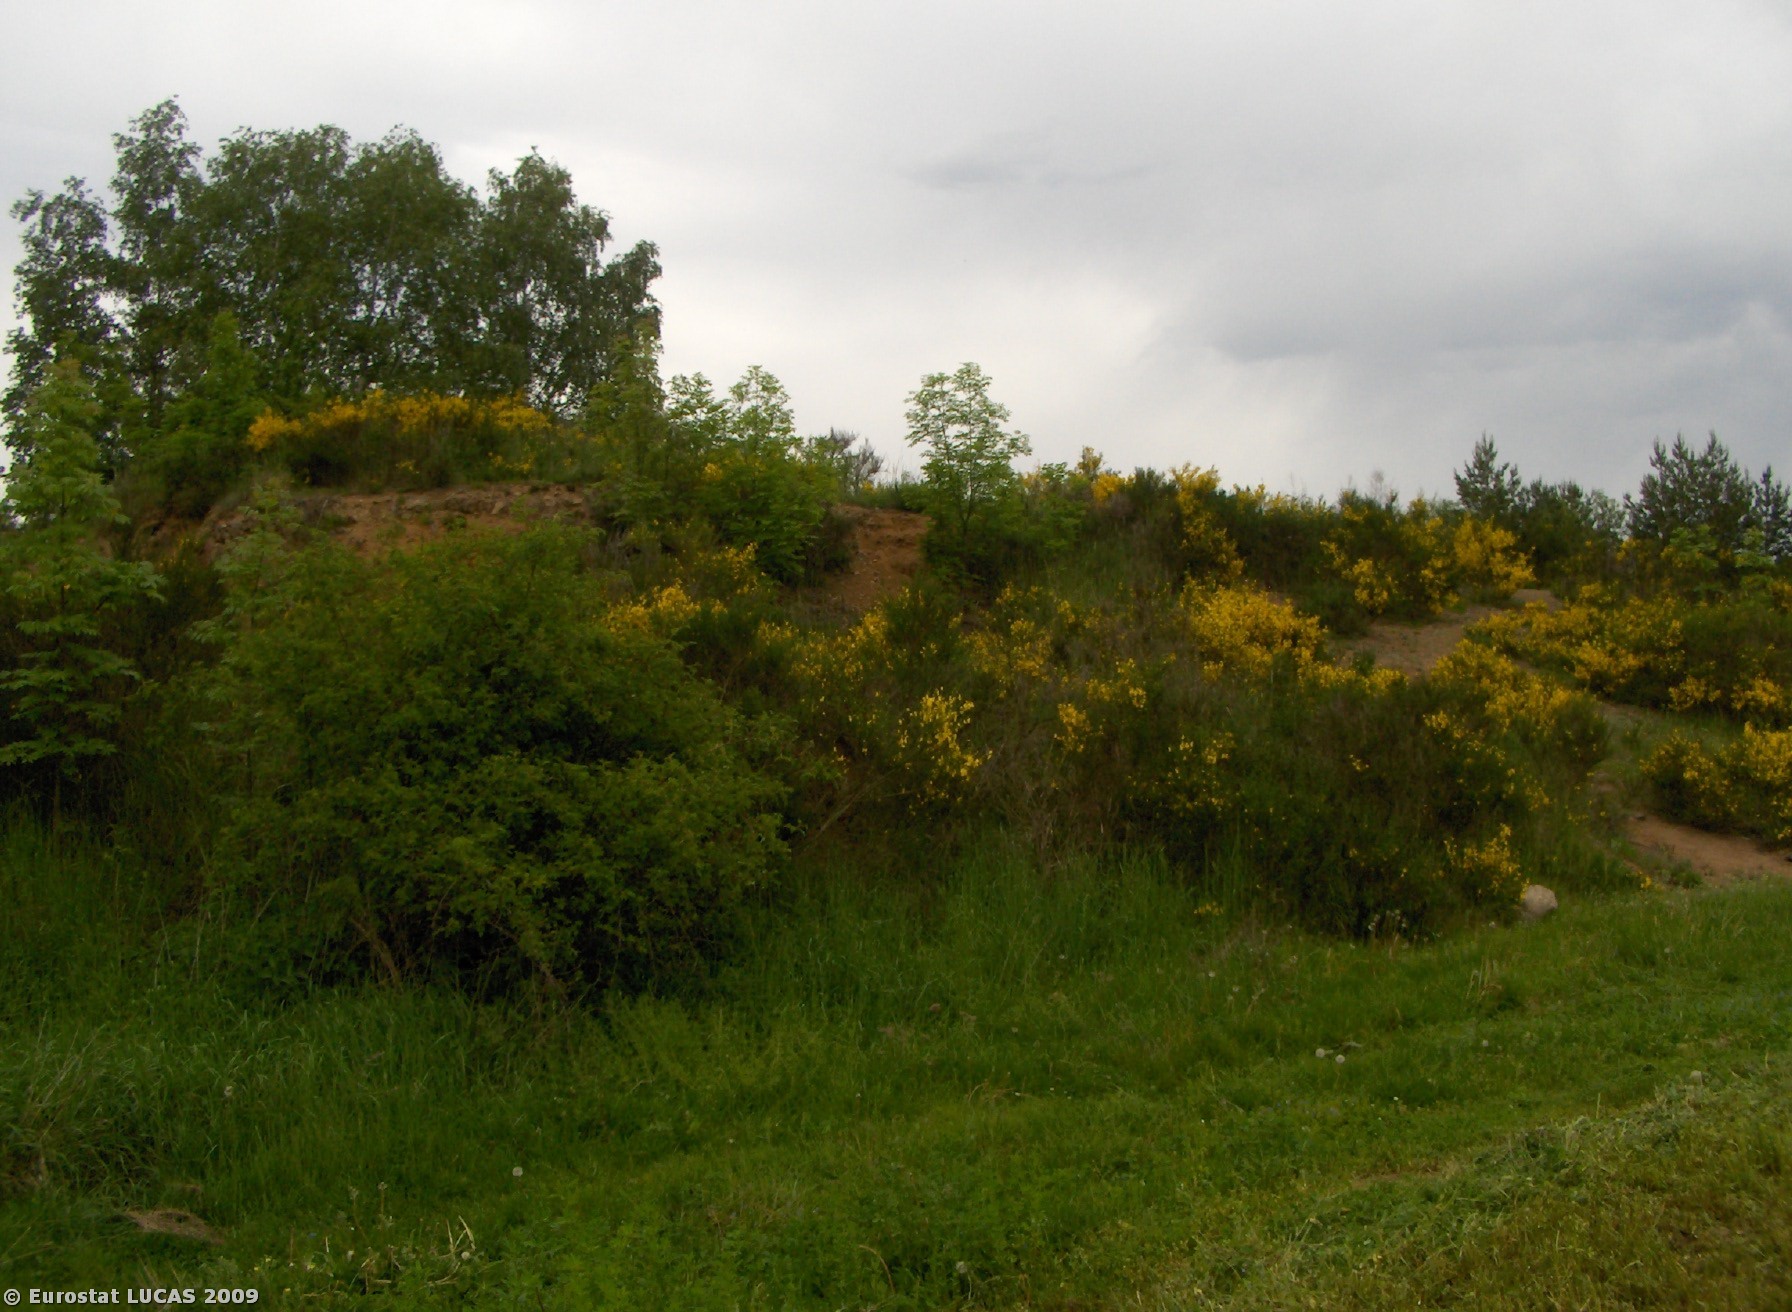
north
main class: Cropland
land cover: Clovers
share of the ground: > 75 %
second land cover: Grassland without tree/shrub cover
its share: 10 - 25 %
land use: Agriculture (excluding fallow land and kitchen gardens)
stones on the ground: < 10 %
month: May
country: CZ
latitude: 49.5491
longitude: 14.1890
